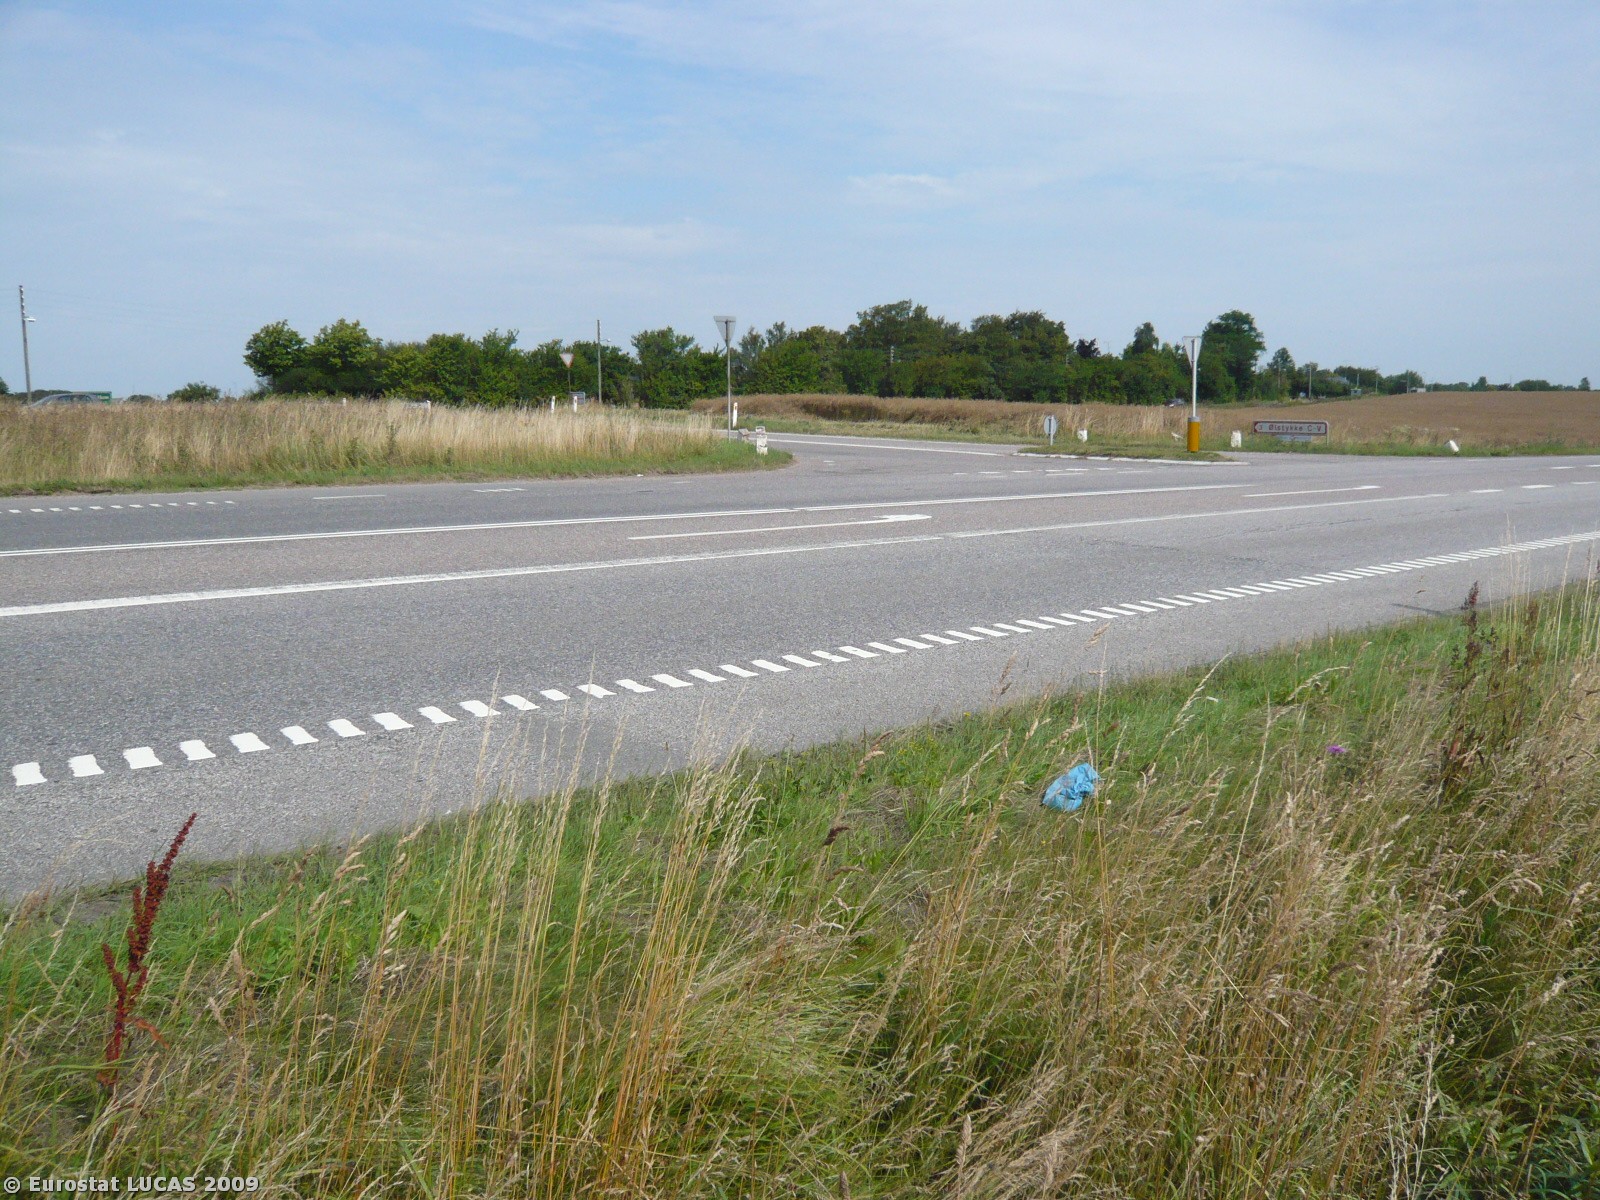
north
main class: Cropland
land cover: Common wheat
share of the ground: > 75 %
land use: Agriculture (excluding fallow land and kitchen gardens)
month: July
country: DK
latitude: 55.7741
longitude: 12.1502
